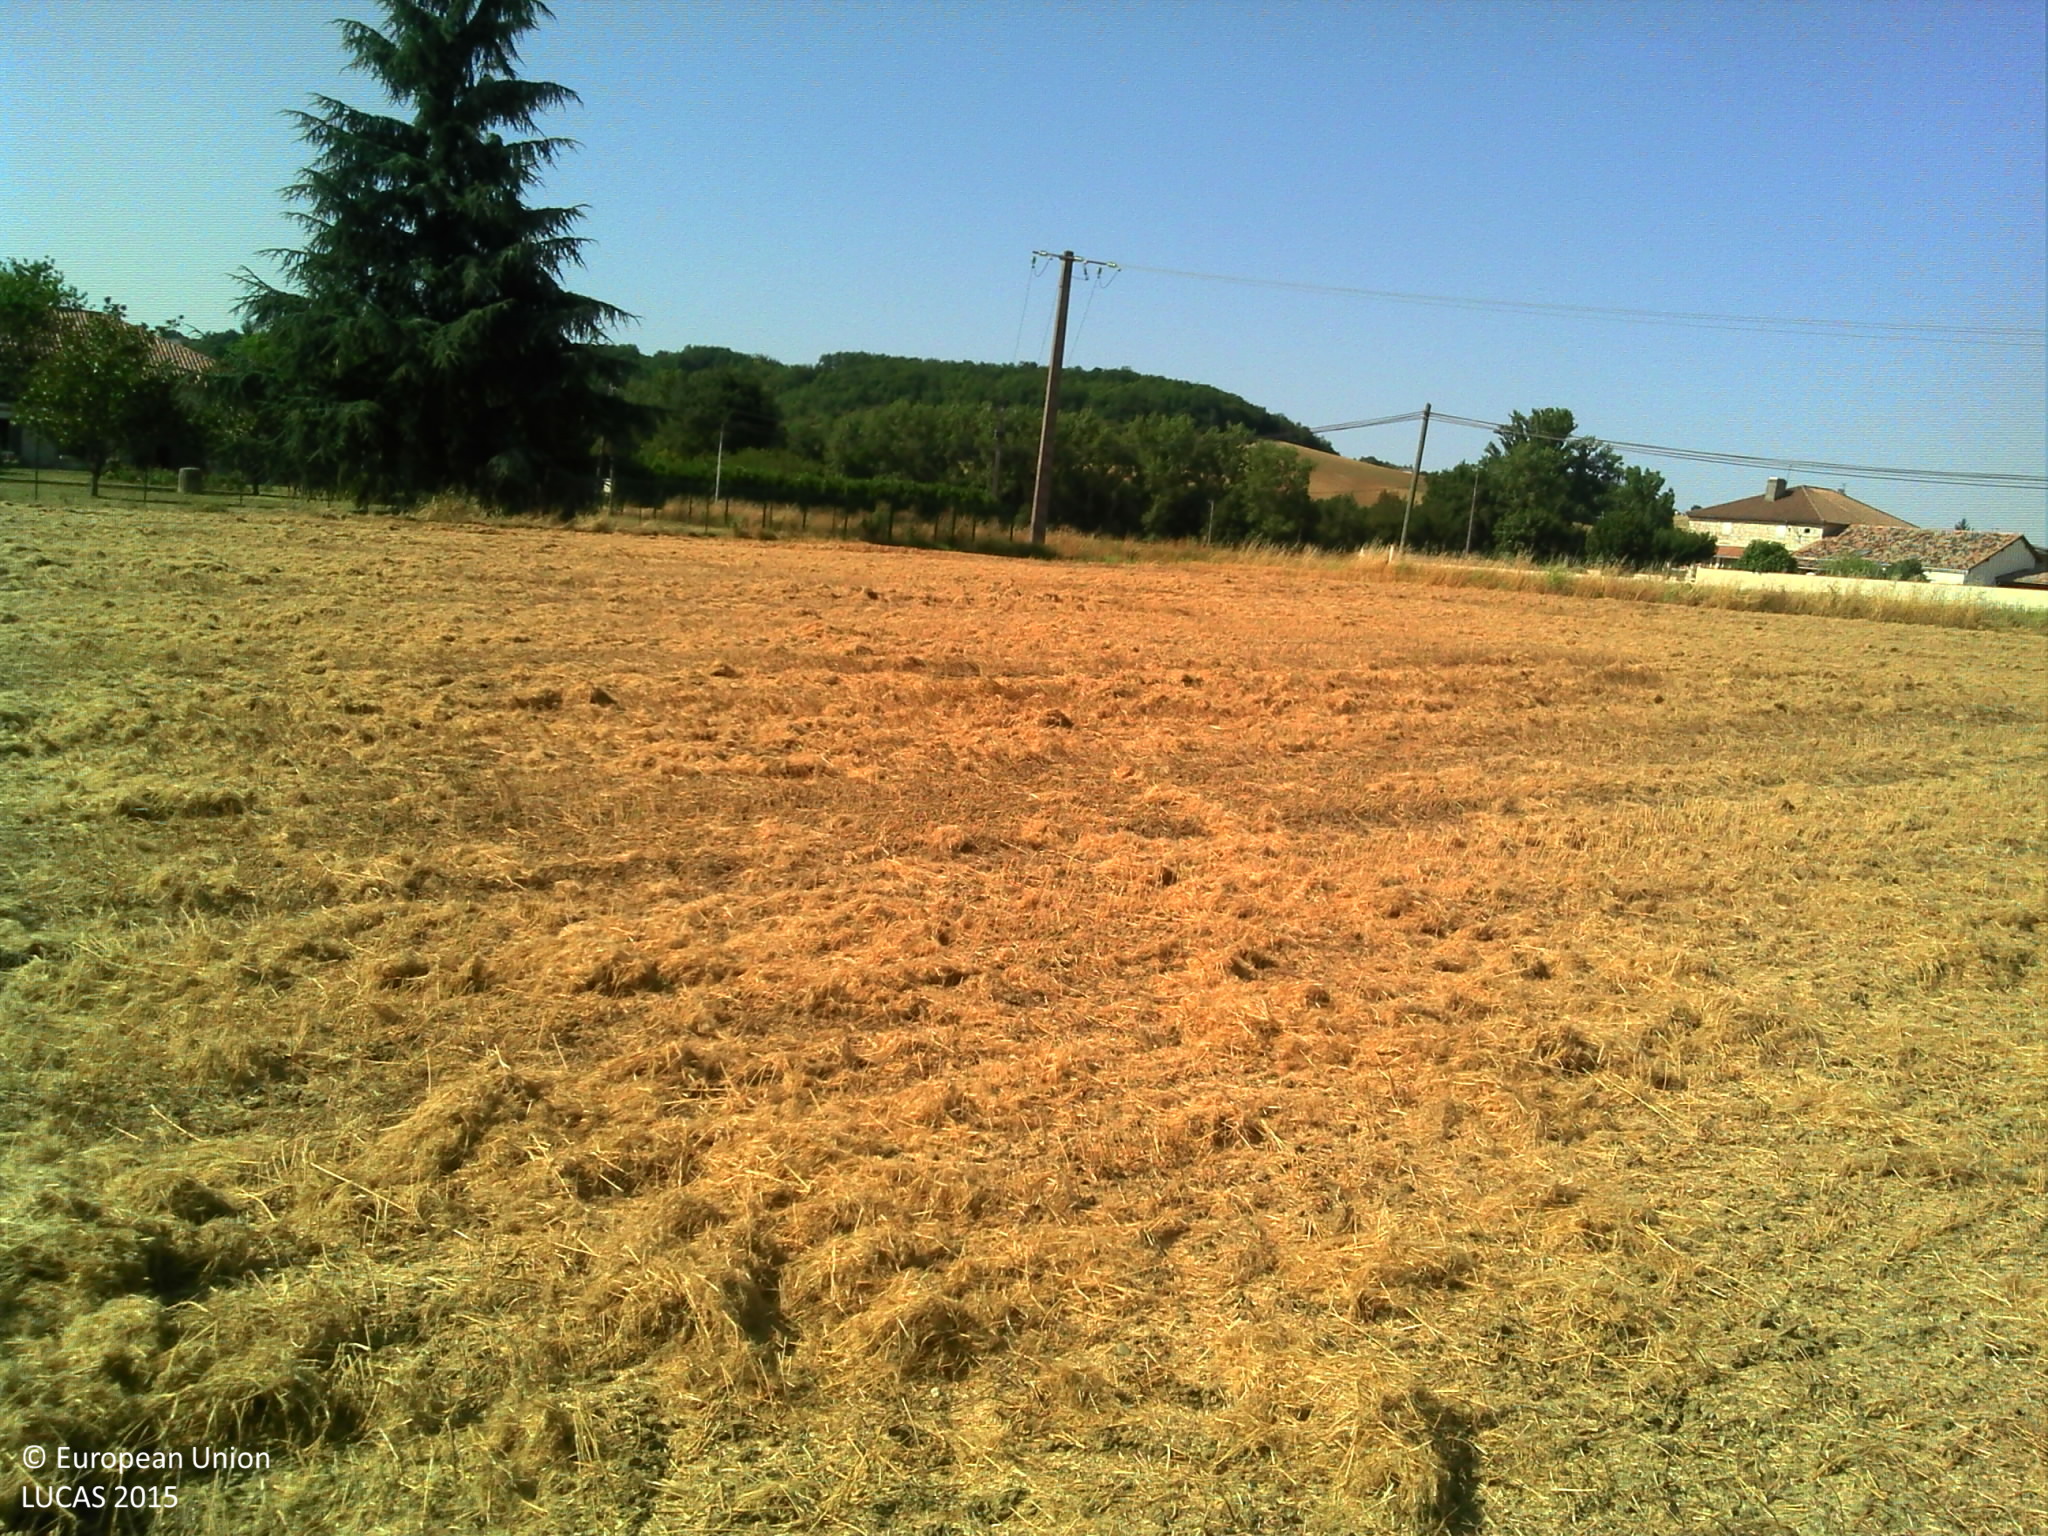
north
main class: Cropland
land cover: Common wheat
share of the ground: 50 - 75 %
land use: Agriculture (excluding fallow land and kitchen gardens)
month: July
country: FR
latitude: 44.1009
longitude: 0.9656
